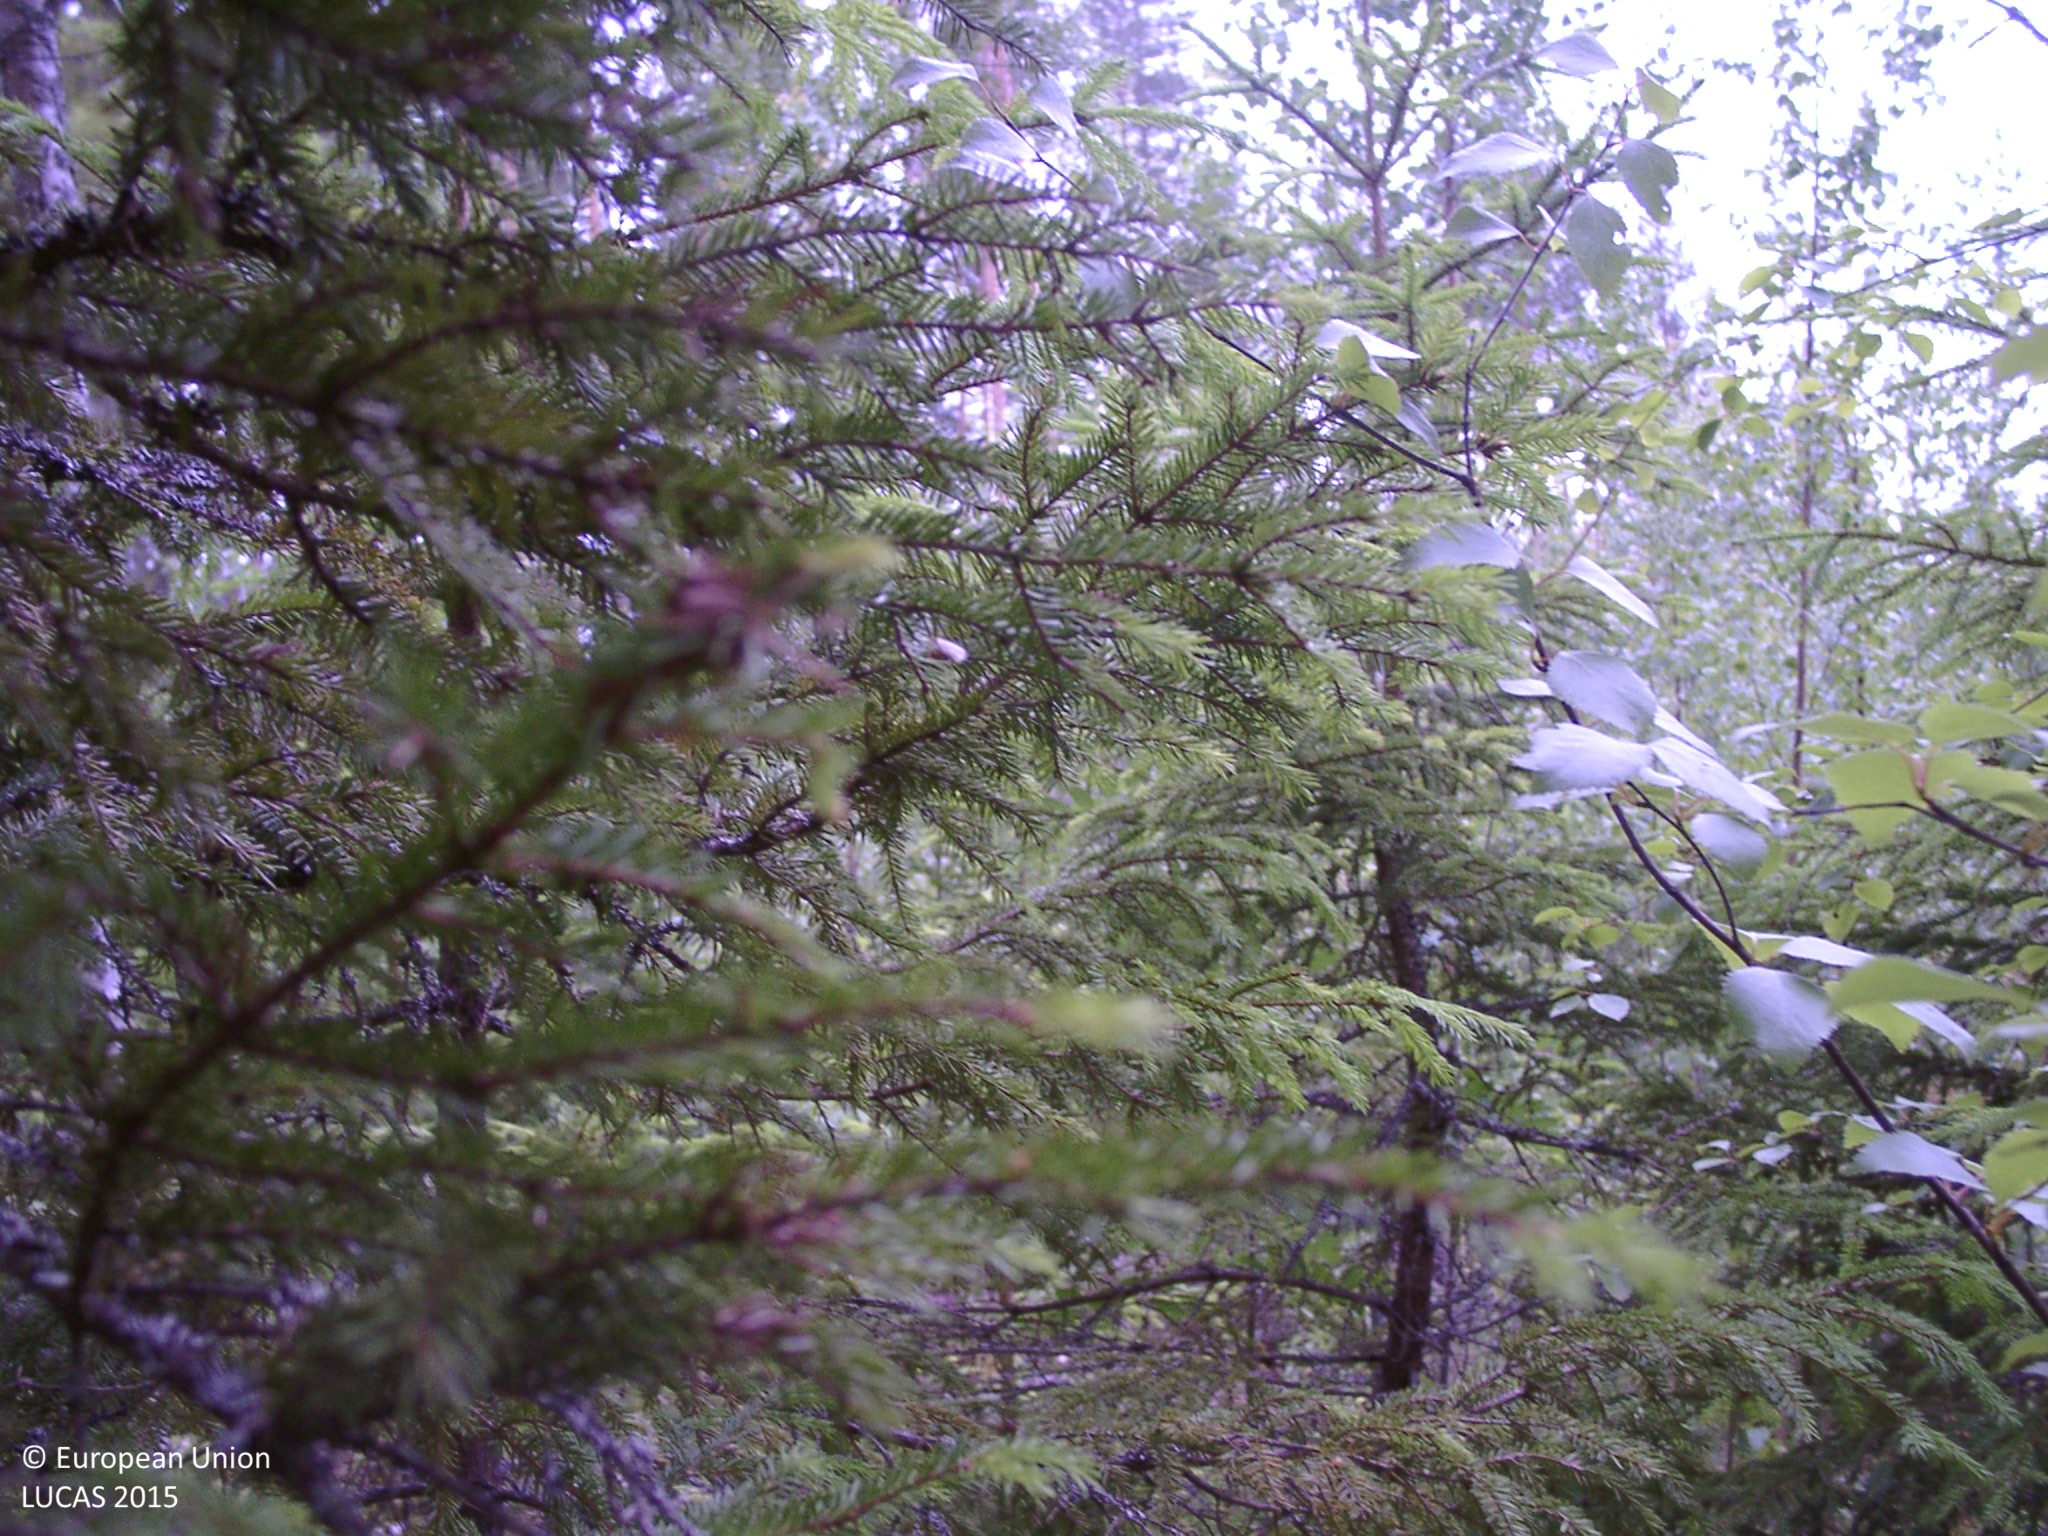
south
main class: Woodland
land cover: Other mixed woodland
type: boreal forest
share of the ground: 50 - 75 %
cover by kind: coniferous forest trees 45 %, broadleaved forest trees 25 %, shrubs 20 %, lichens and mosses 10 %
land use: Forestry
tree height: > 5 m
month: June
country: FI
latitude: 62.0665
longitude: 25.0894
